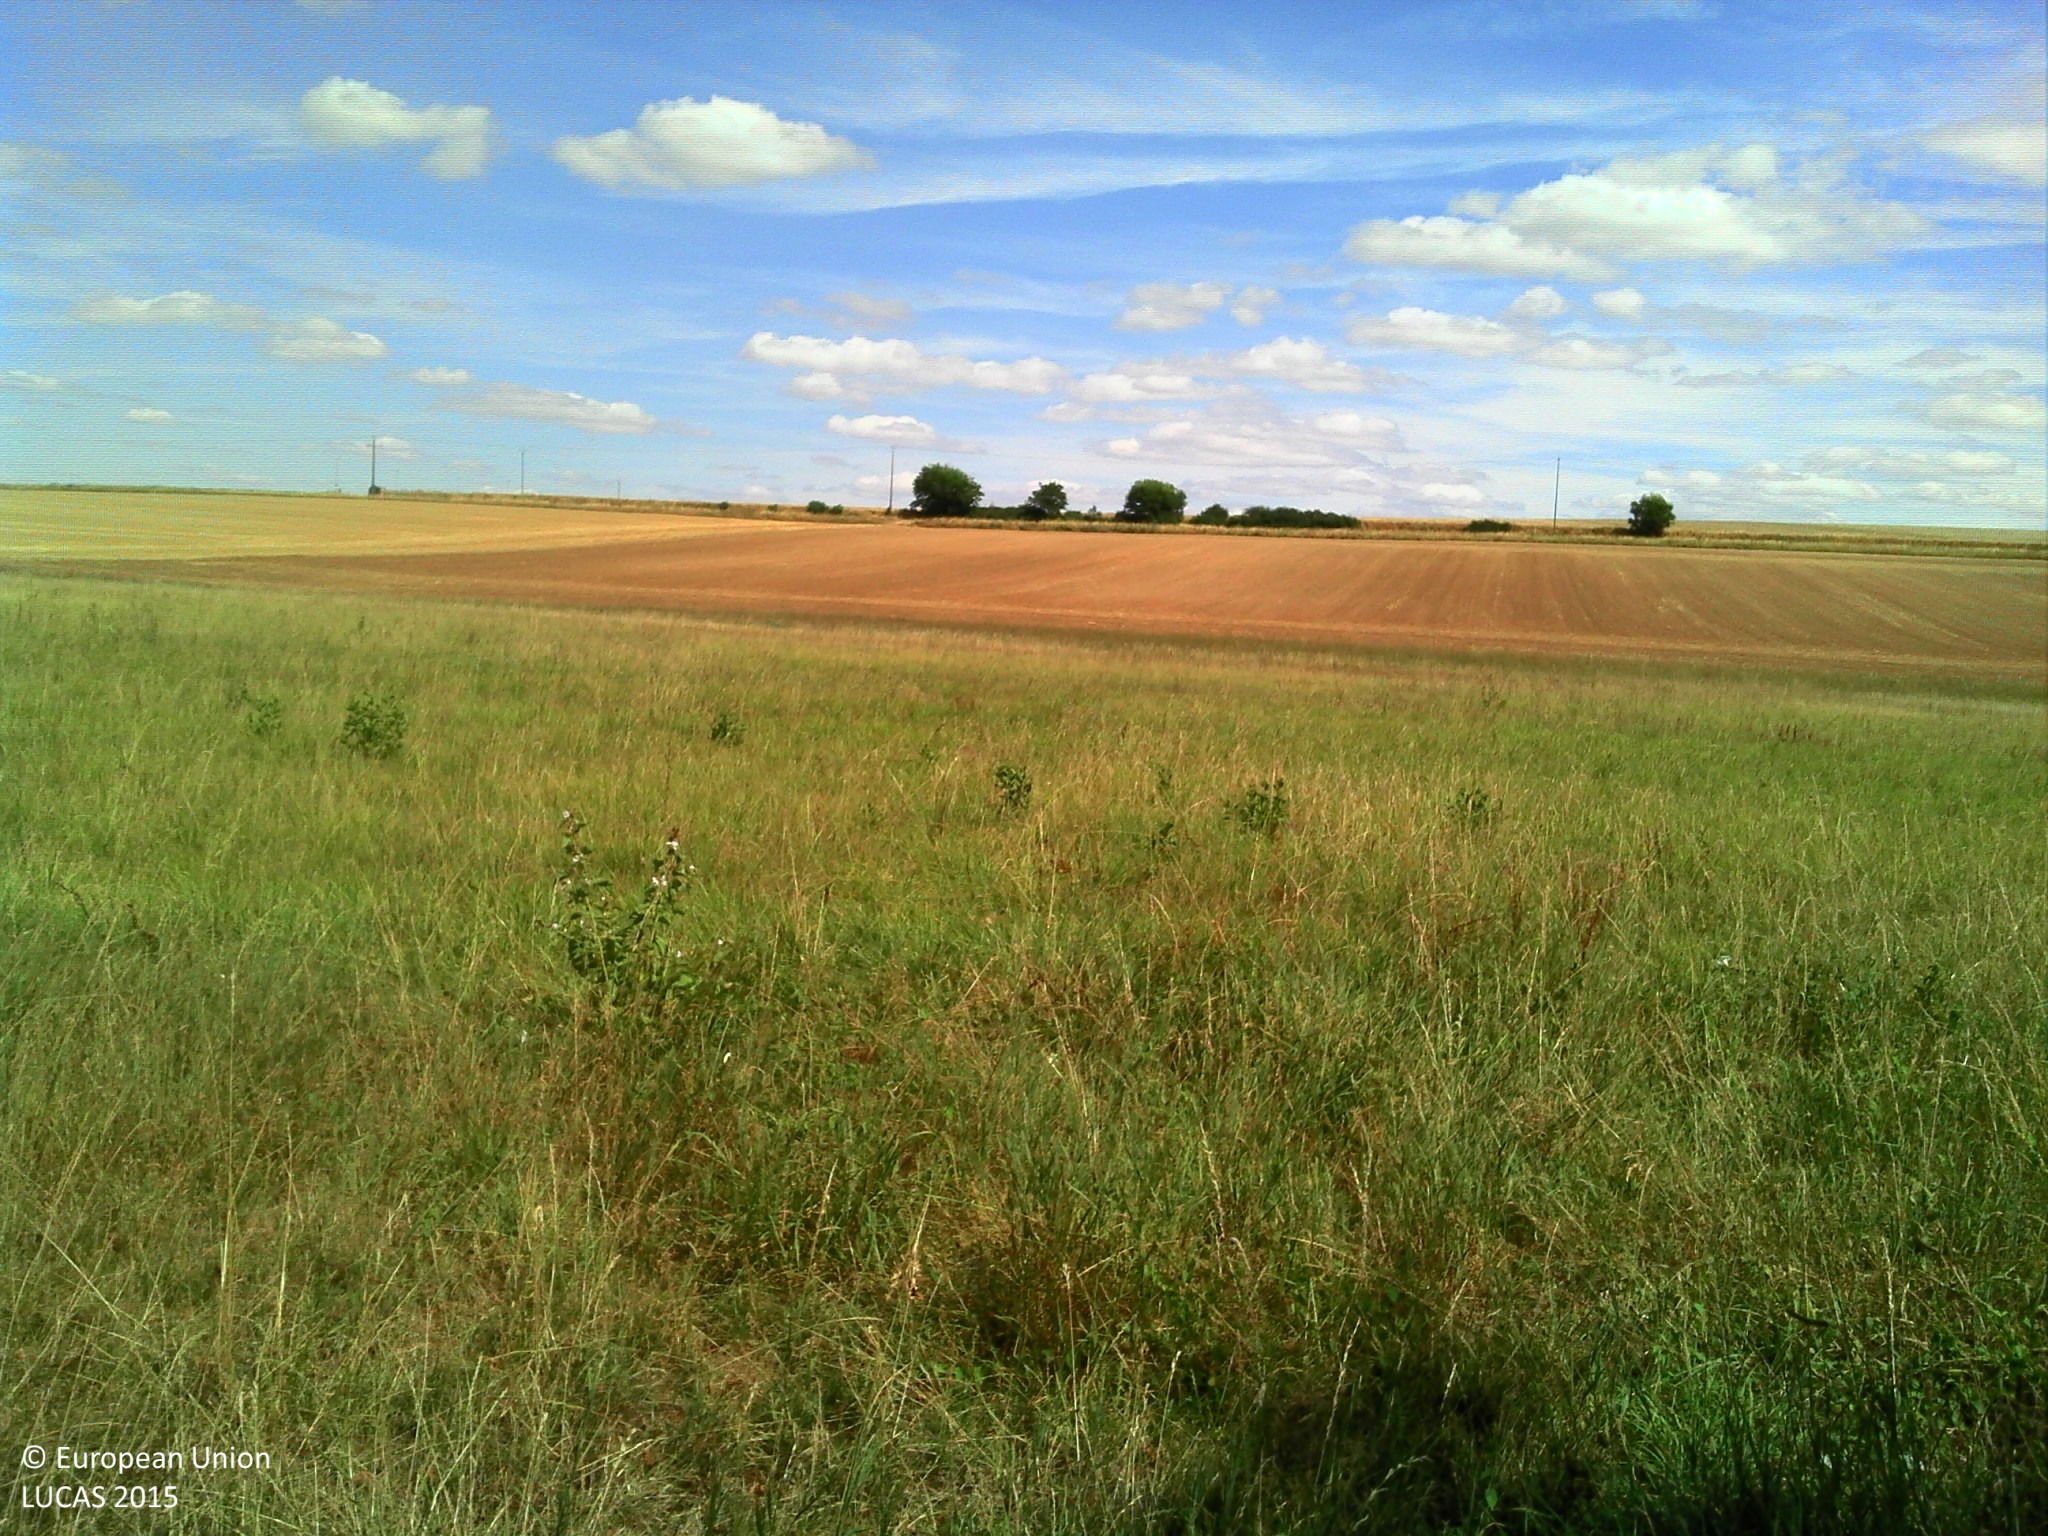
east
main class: Grassland
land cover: Grassland without tree/shrub cover
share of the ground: > 75 %
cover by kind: herbaceous plants 100 %
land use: Agriculture (excluding fallow land and kitchen gardens)
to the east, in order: Grassland without tree/shrub cover; Common wheat
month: July
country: FR
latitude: 46.9826
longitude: 2.1166
